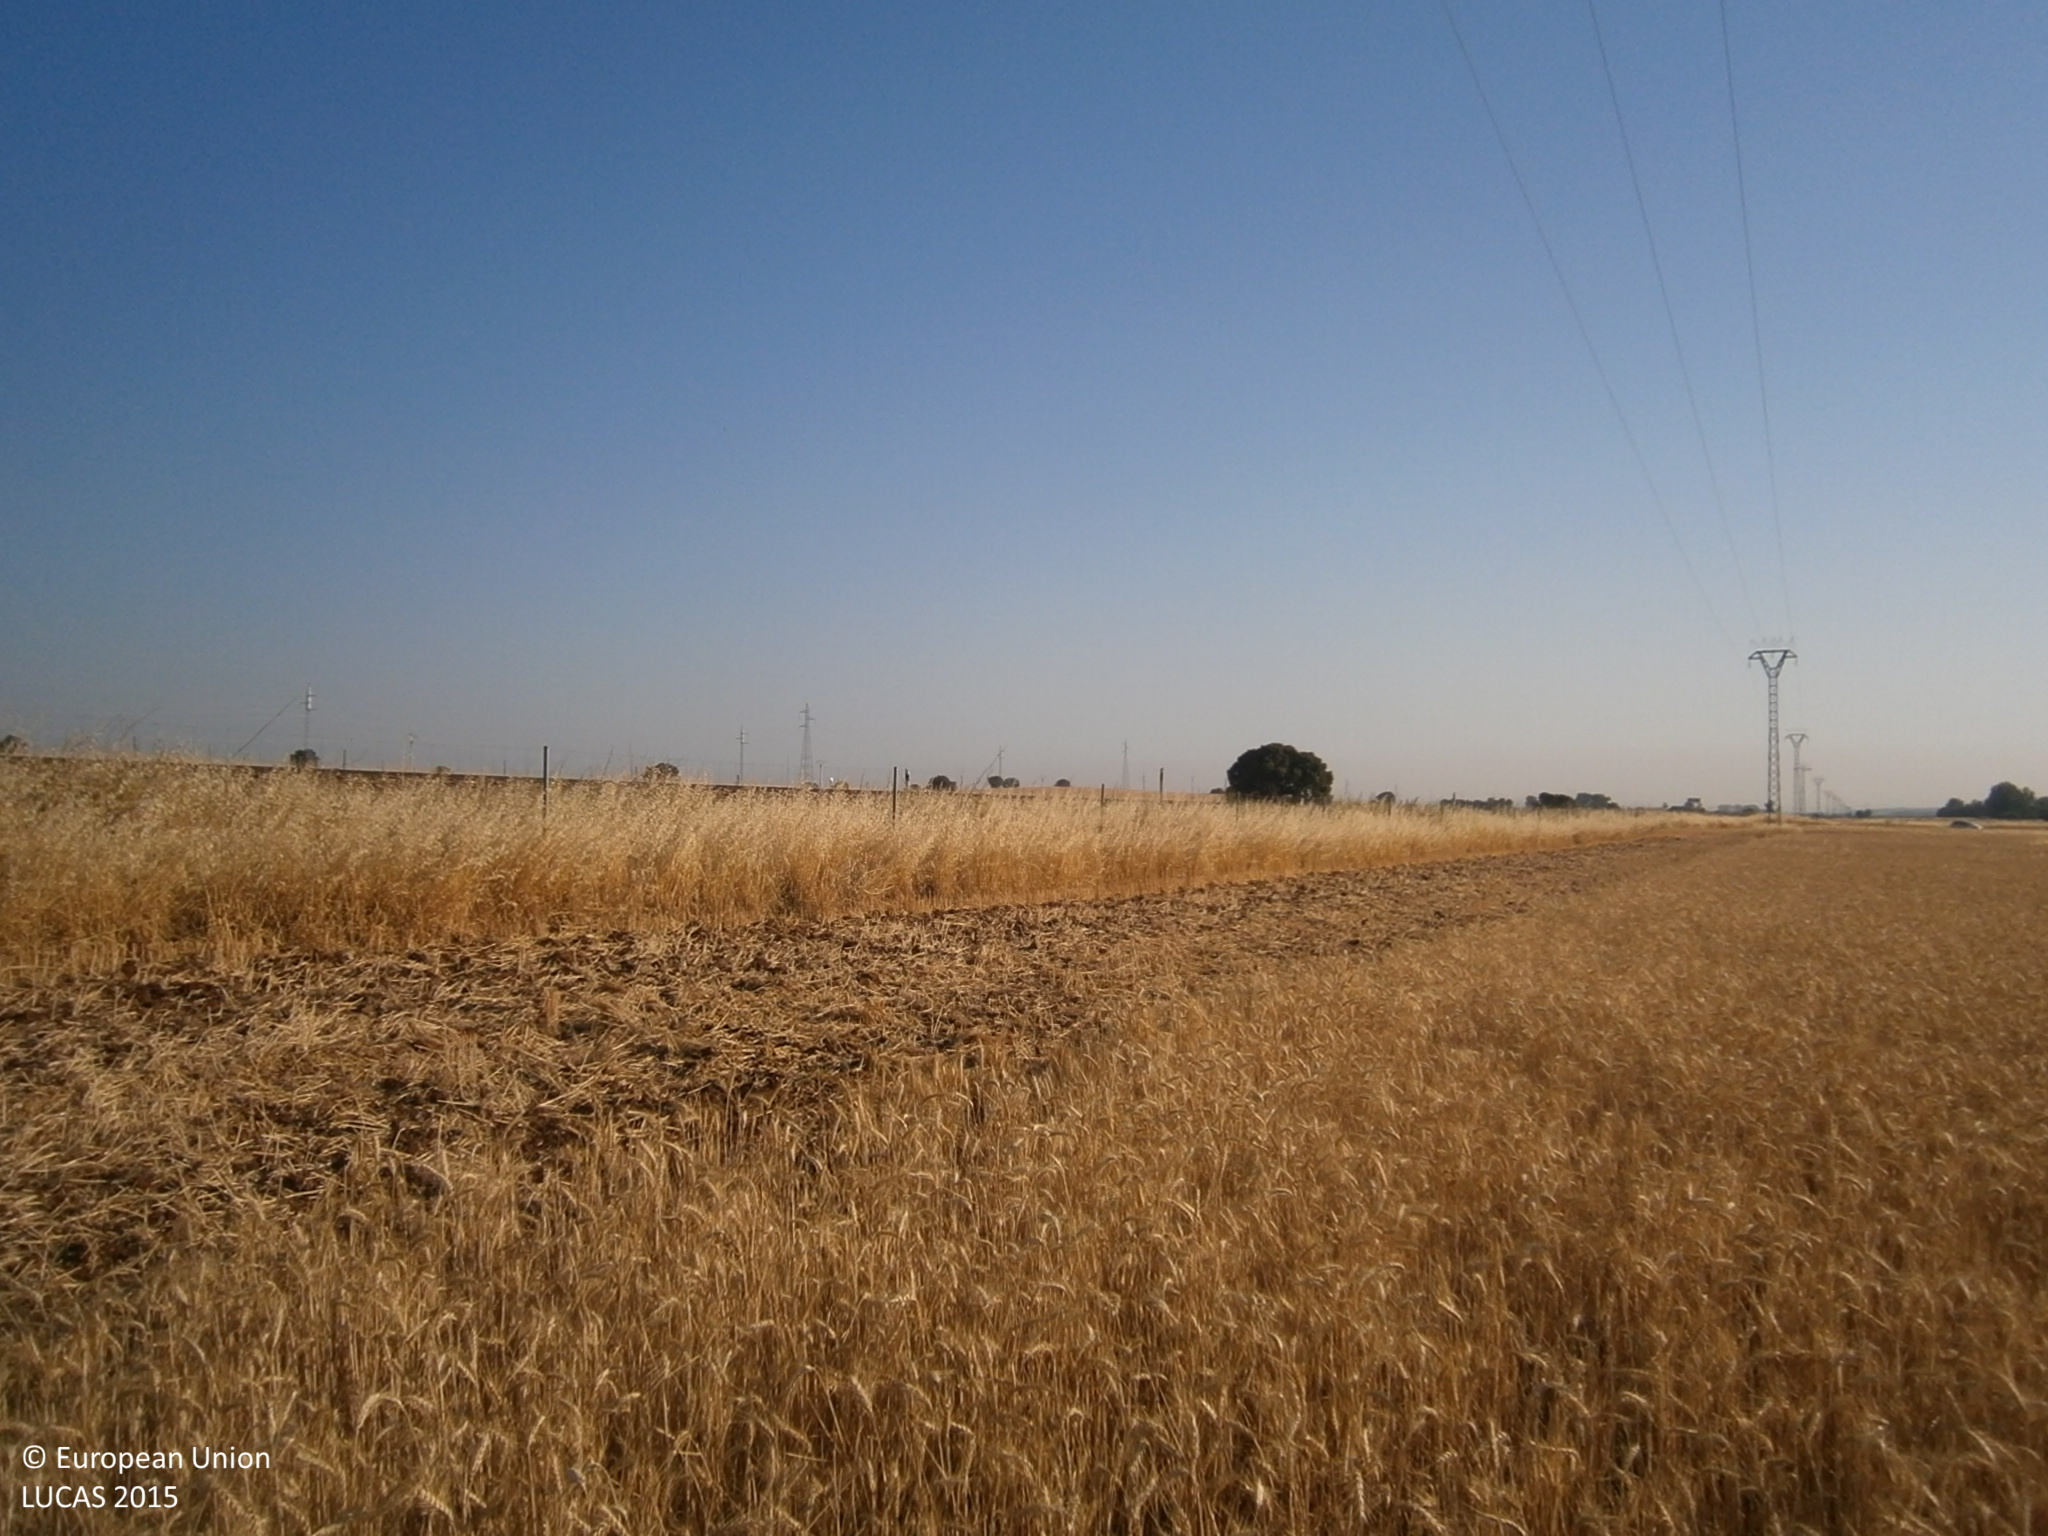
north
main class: Cropland
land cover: Barley
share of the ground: > 75 %
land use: Agriculture (excluding fallow land and kitchen gardens)
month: June
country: ES
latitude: 38.7506
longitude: -6.8058
